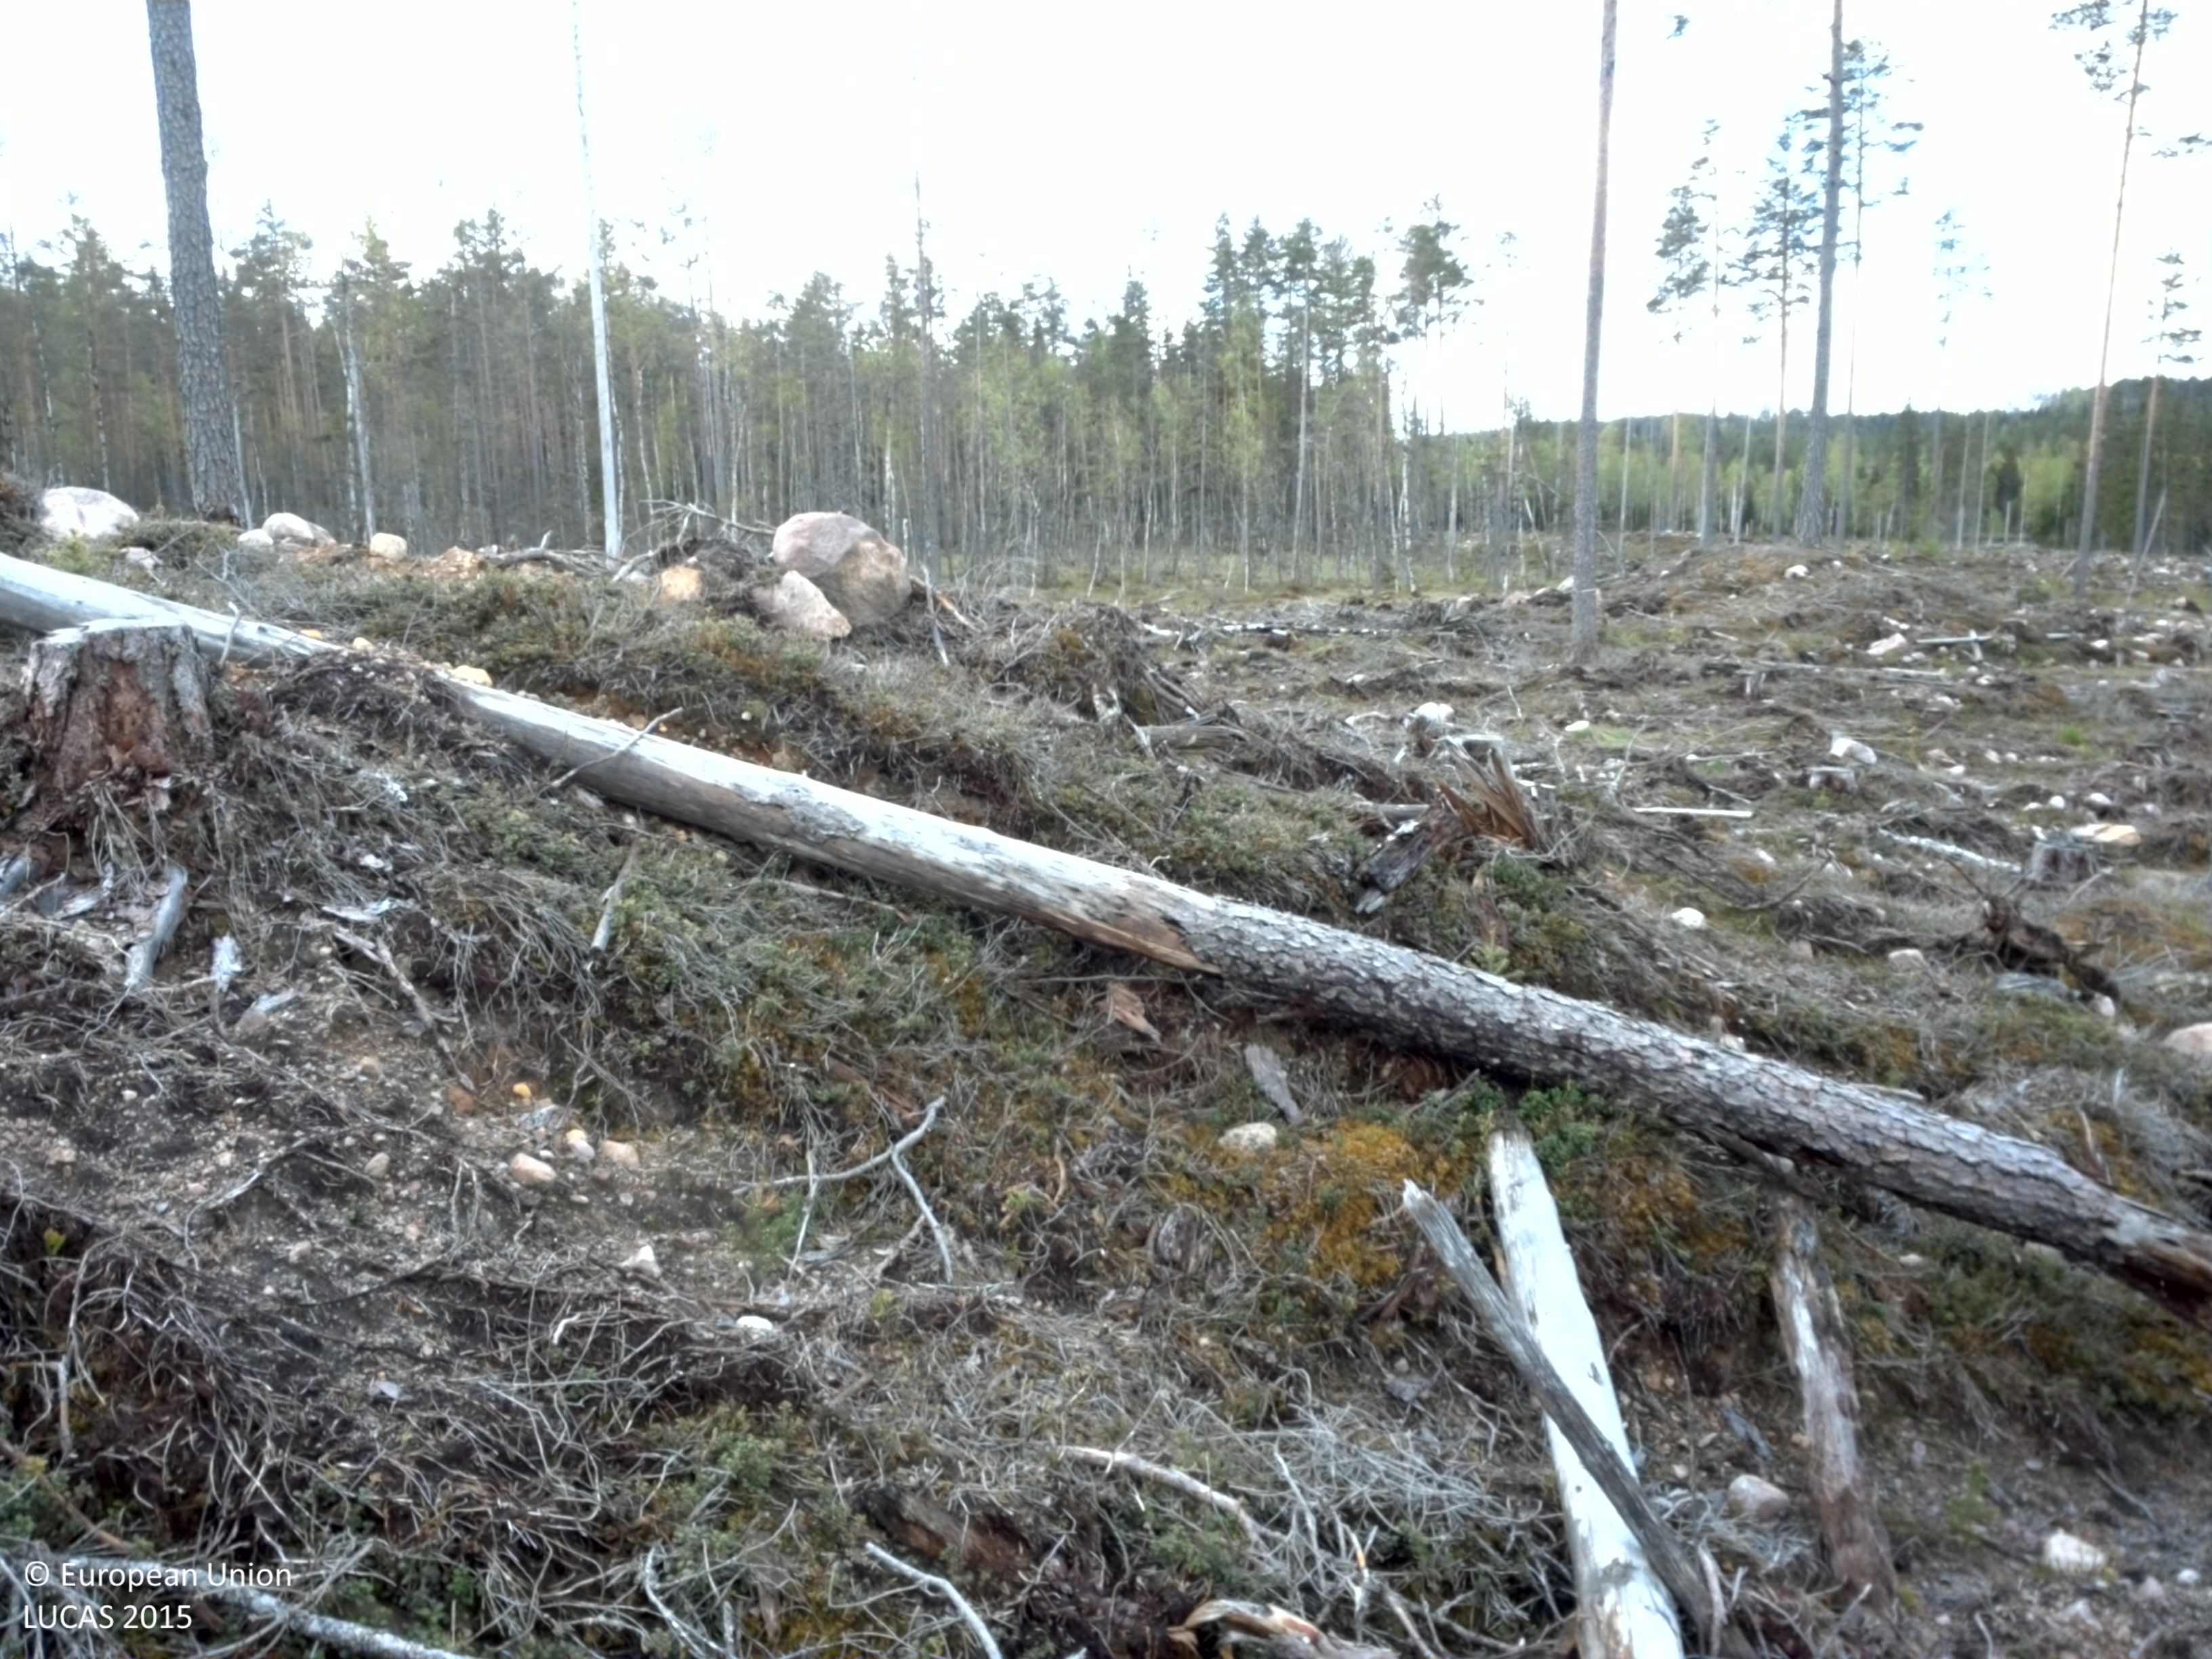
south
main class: Shrubland
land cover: Shrubland with sparse tree cover
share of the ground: 10 - 25 %
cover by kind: shrubs 10 %, herbaceous plants 10 %, coniferous forest trees 5 %, lichens and mosses 5 %
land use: Forestry
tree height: > 5 m
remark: Clear cut
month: May
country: SE
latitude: 60.3358
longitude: 13.4861
